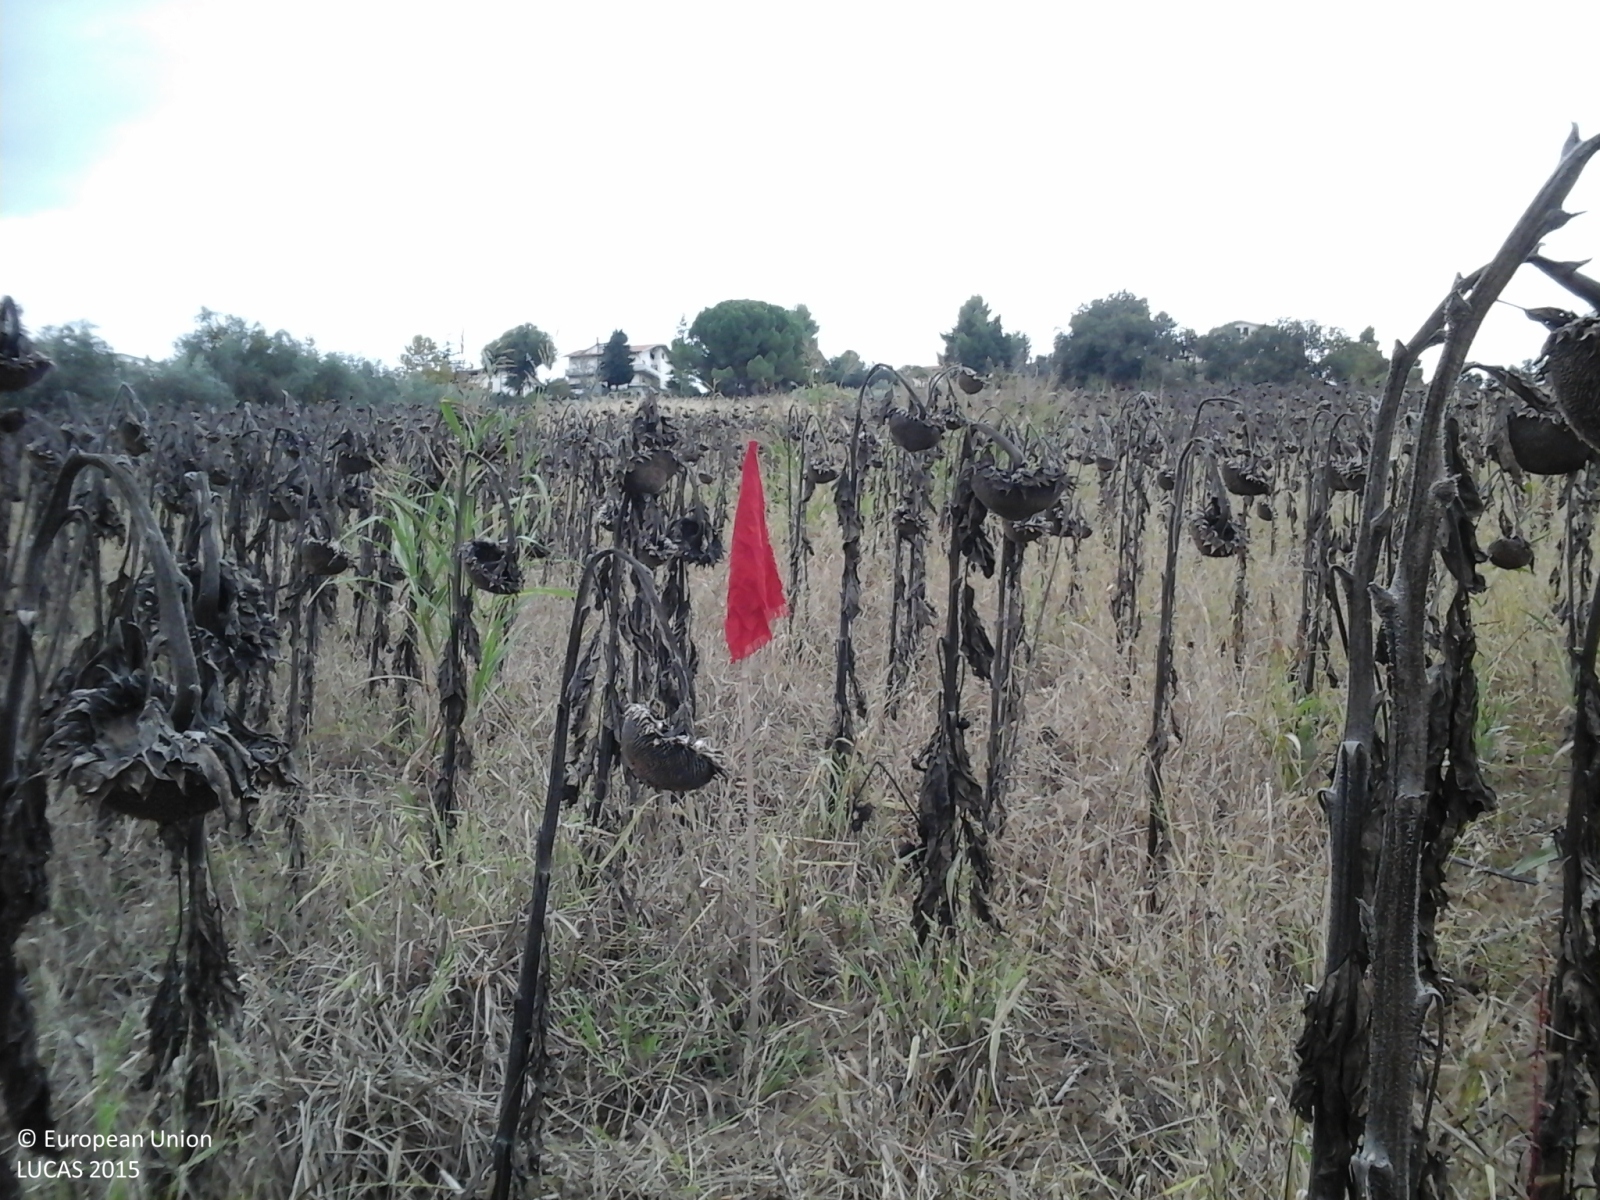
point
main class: Cropland
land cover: Sunflower
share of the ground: > 75 %
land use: Agriculture (excluding fallow land and kitchen gardens)
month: October
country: IT
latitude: 43.5799
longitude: 13.1749
